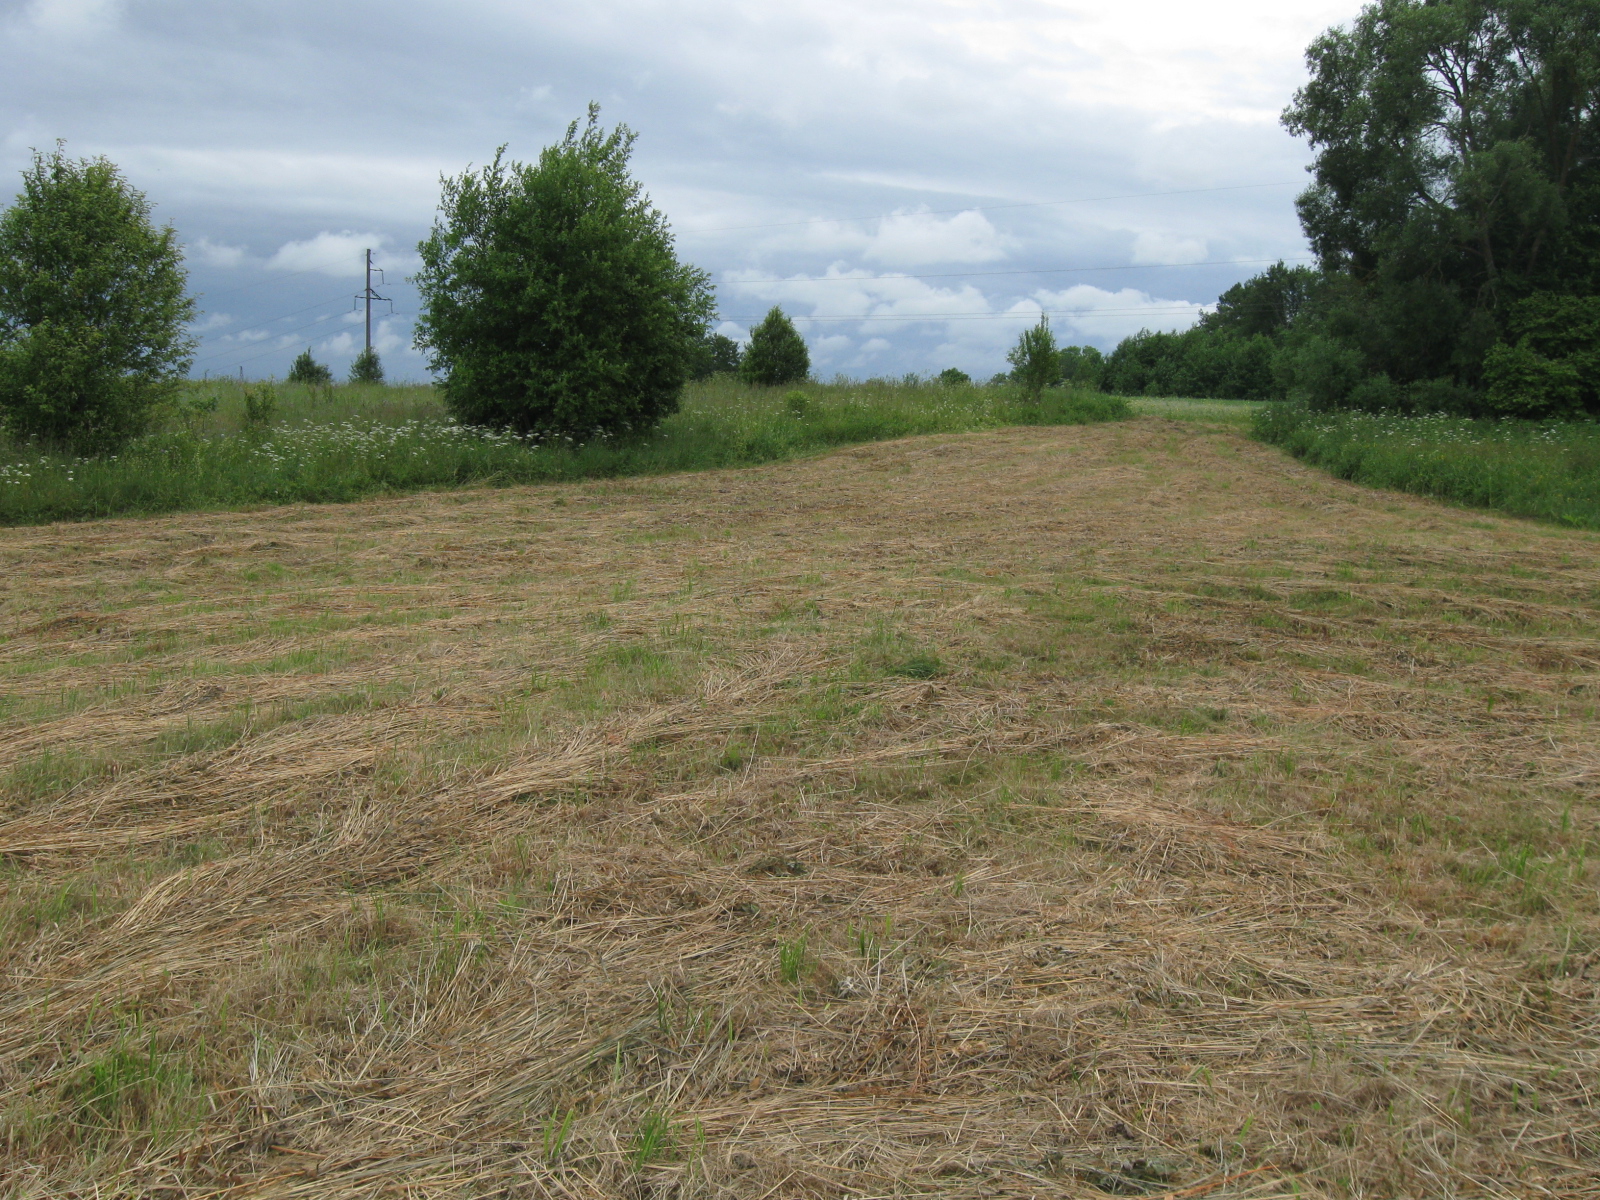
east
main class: Grassland
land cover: Grassland without tree/shrub cover
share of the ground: > 75 %
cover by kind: herbaceous plants 90 %, unconsolidated bare surface 10 %
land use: Agriculture (excluding fallow land and kitchen gardens)
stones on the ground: < 10 %
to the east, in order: Grassland without tree/shrub cover; Single bushes/trees; Common wheat; Abandoned hedges; Tracks; Grass margins; Other cereals; Electric lines; Other cereals; Broadleaved woodland
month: June
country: LT
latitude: 54.7709
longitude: 24.5124
